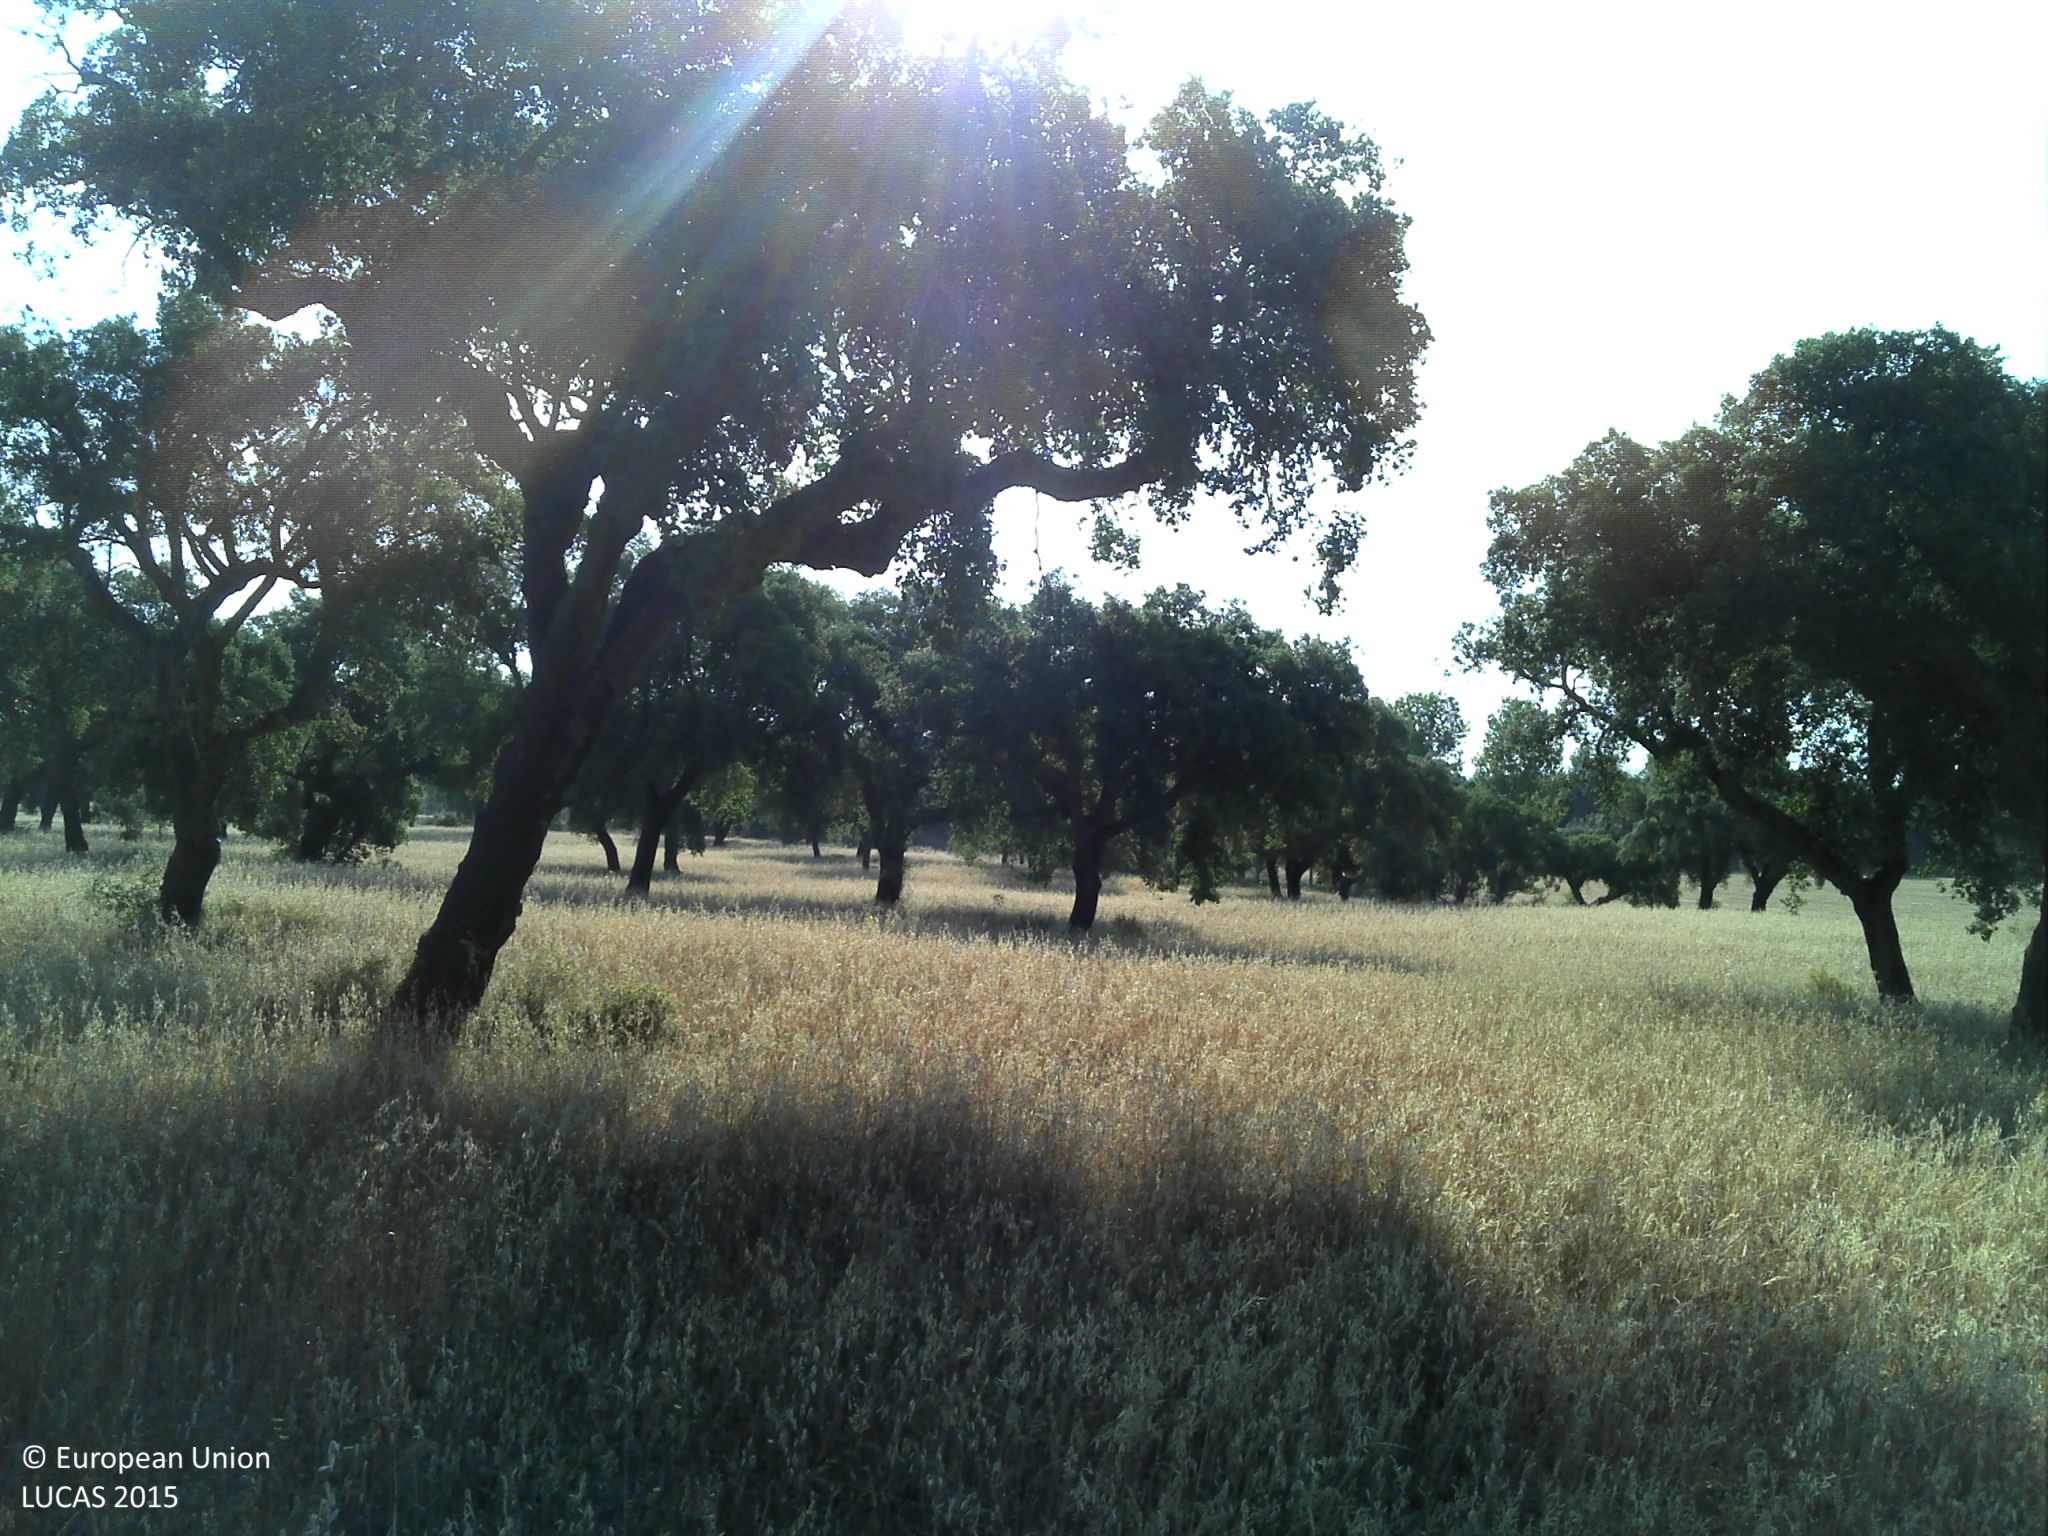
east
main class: Woodland
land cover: Broadleaved woodland
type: broadleaved evergreen forest
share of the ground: 25 - 50 %
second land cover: Oats
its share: 50 - 75 %
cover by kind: herbaceous plants 60 %, broadleaved forest trees 30 %, unconsolidated bare surface 10 %
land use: Forestry
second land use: Agriculture (excluding fallow land and kitchen gardens)
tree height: > 5 m
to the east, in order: Broadleaved woodland; Oats; Broadleaved woodland; Fences; Shruby margins; Tracks; Broadleaved woodland; Ditches and canals; Oats; Lines of trees; Grass margins; Paved roads, cycling and walking lanes; Shruby margins; Fences; Broadleaved woodland
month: May
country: PT
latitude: 38.9173
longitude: -7.8166
